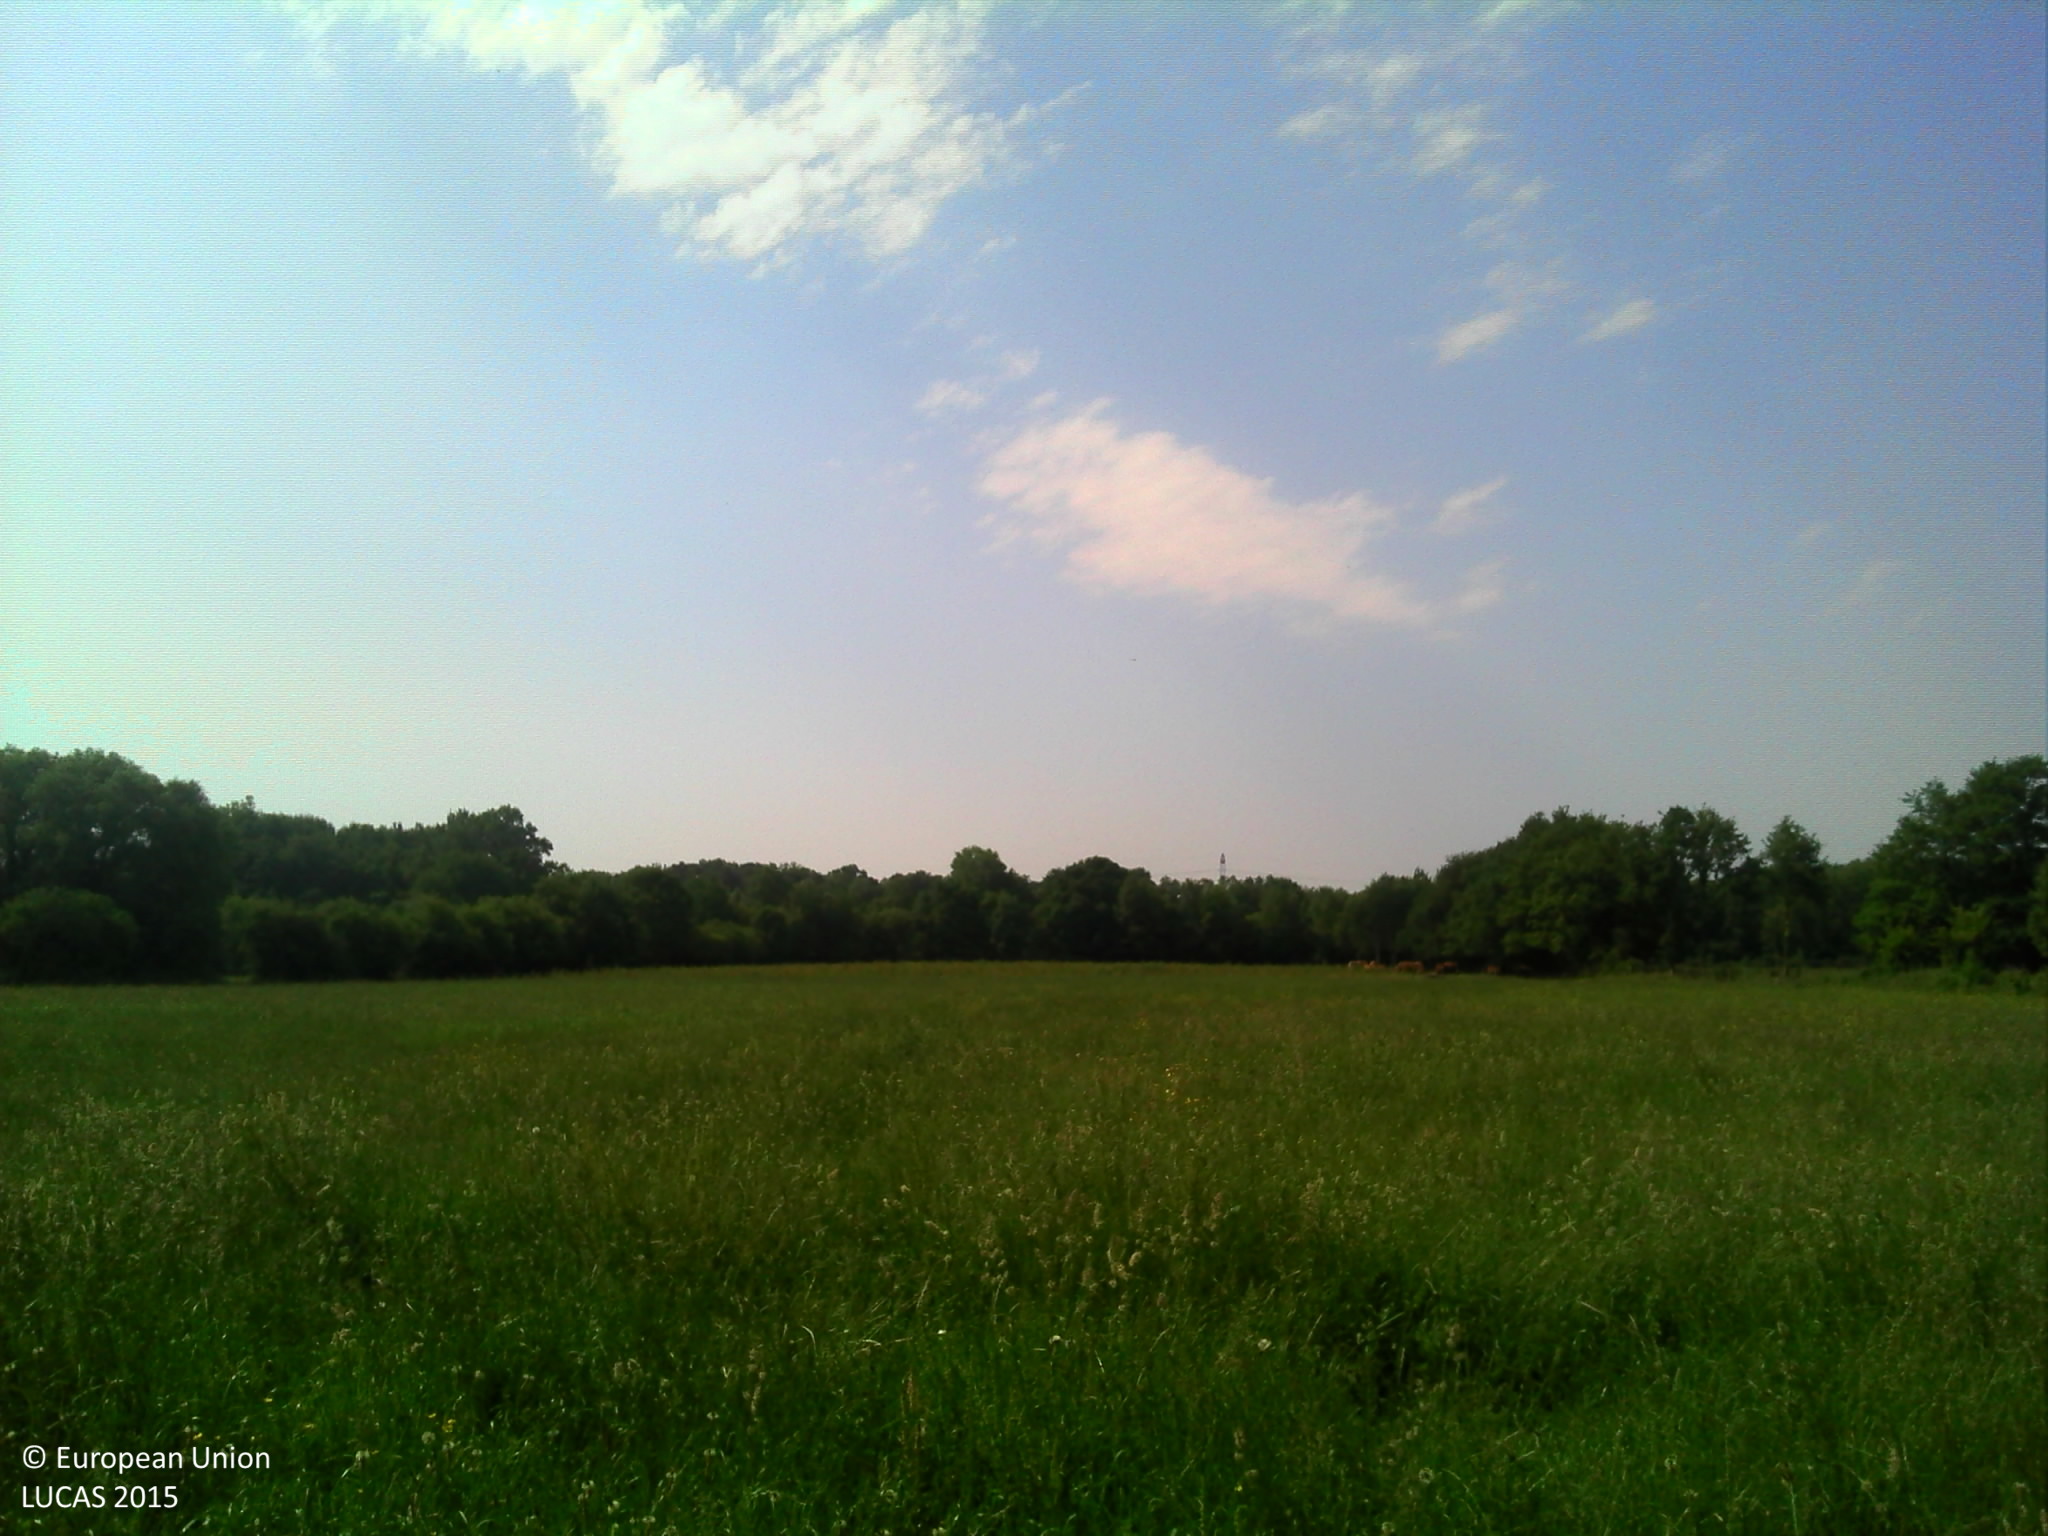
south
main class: Grassland
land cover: Grassland without tree/shrub cover
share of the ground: > 75 %
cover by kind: herbaceous plants 100 %
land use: Agriculture (excluding fallow land and kitchen gardens)
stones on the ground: < 10 %
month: June
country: FR
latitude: 47.8597
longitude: 0.0147
